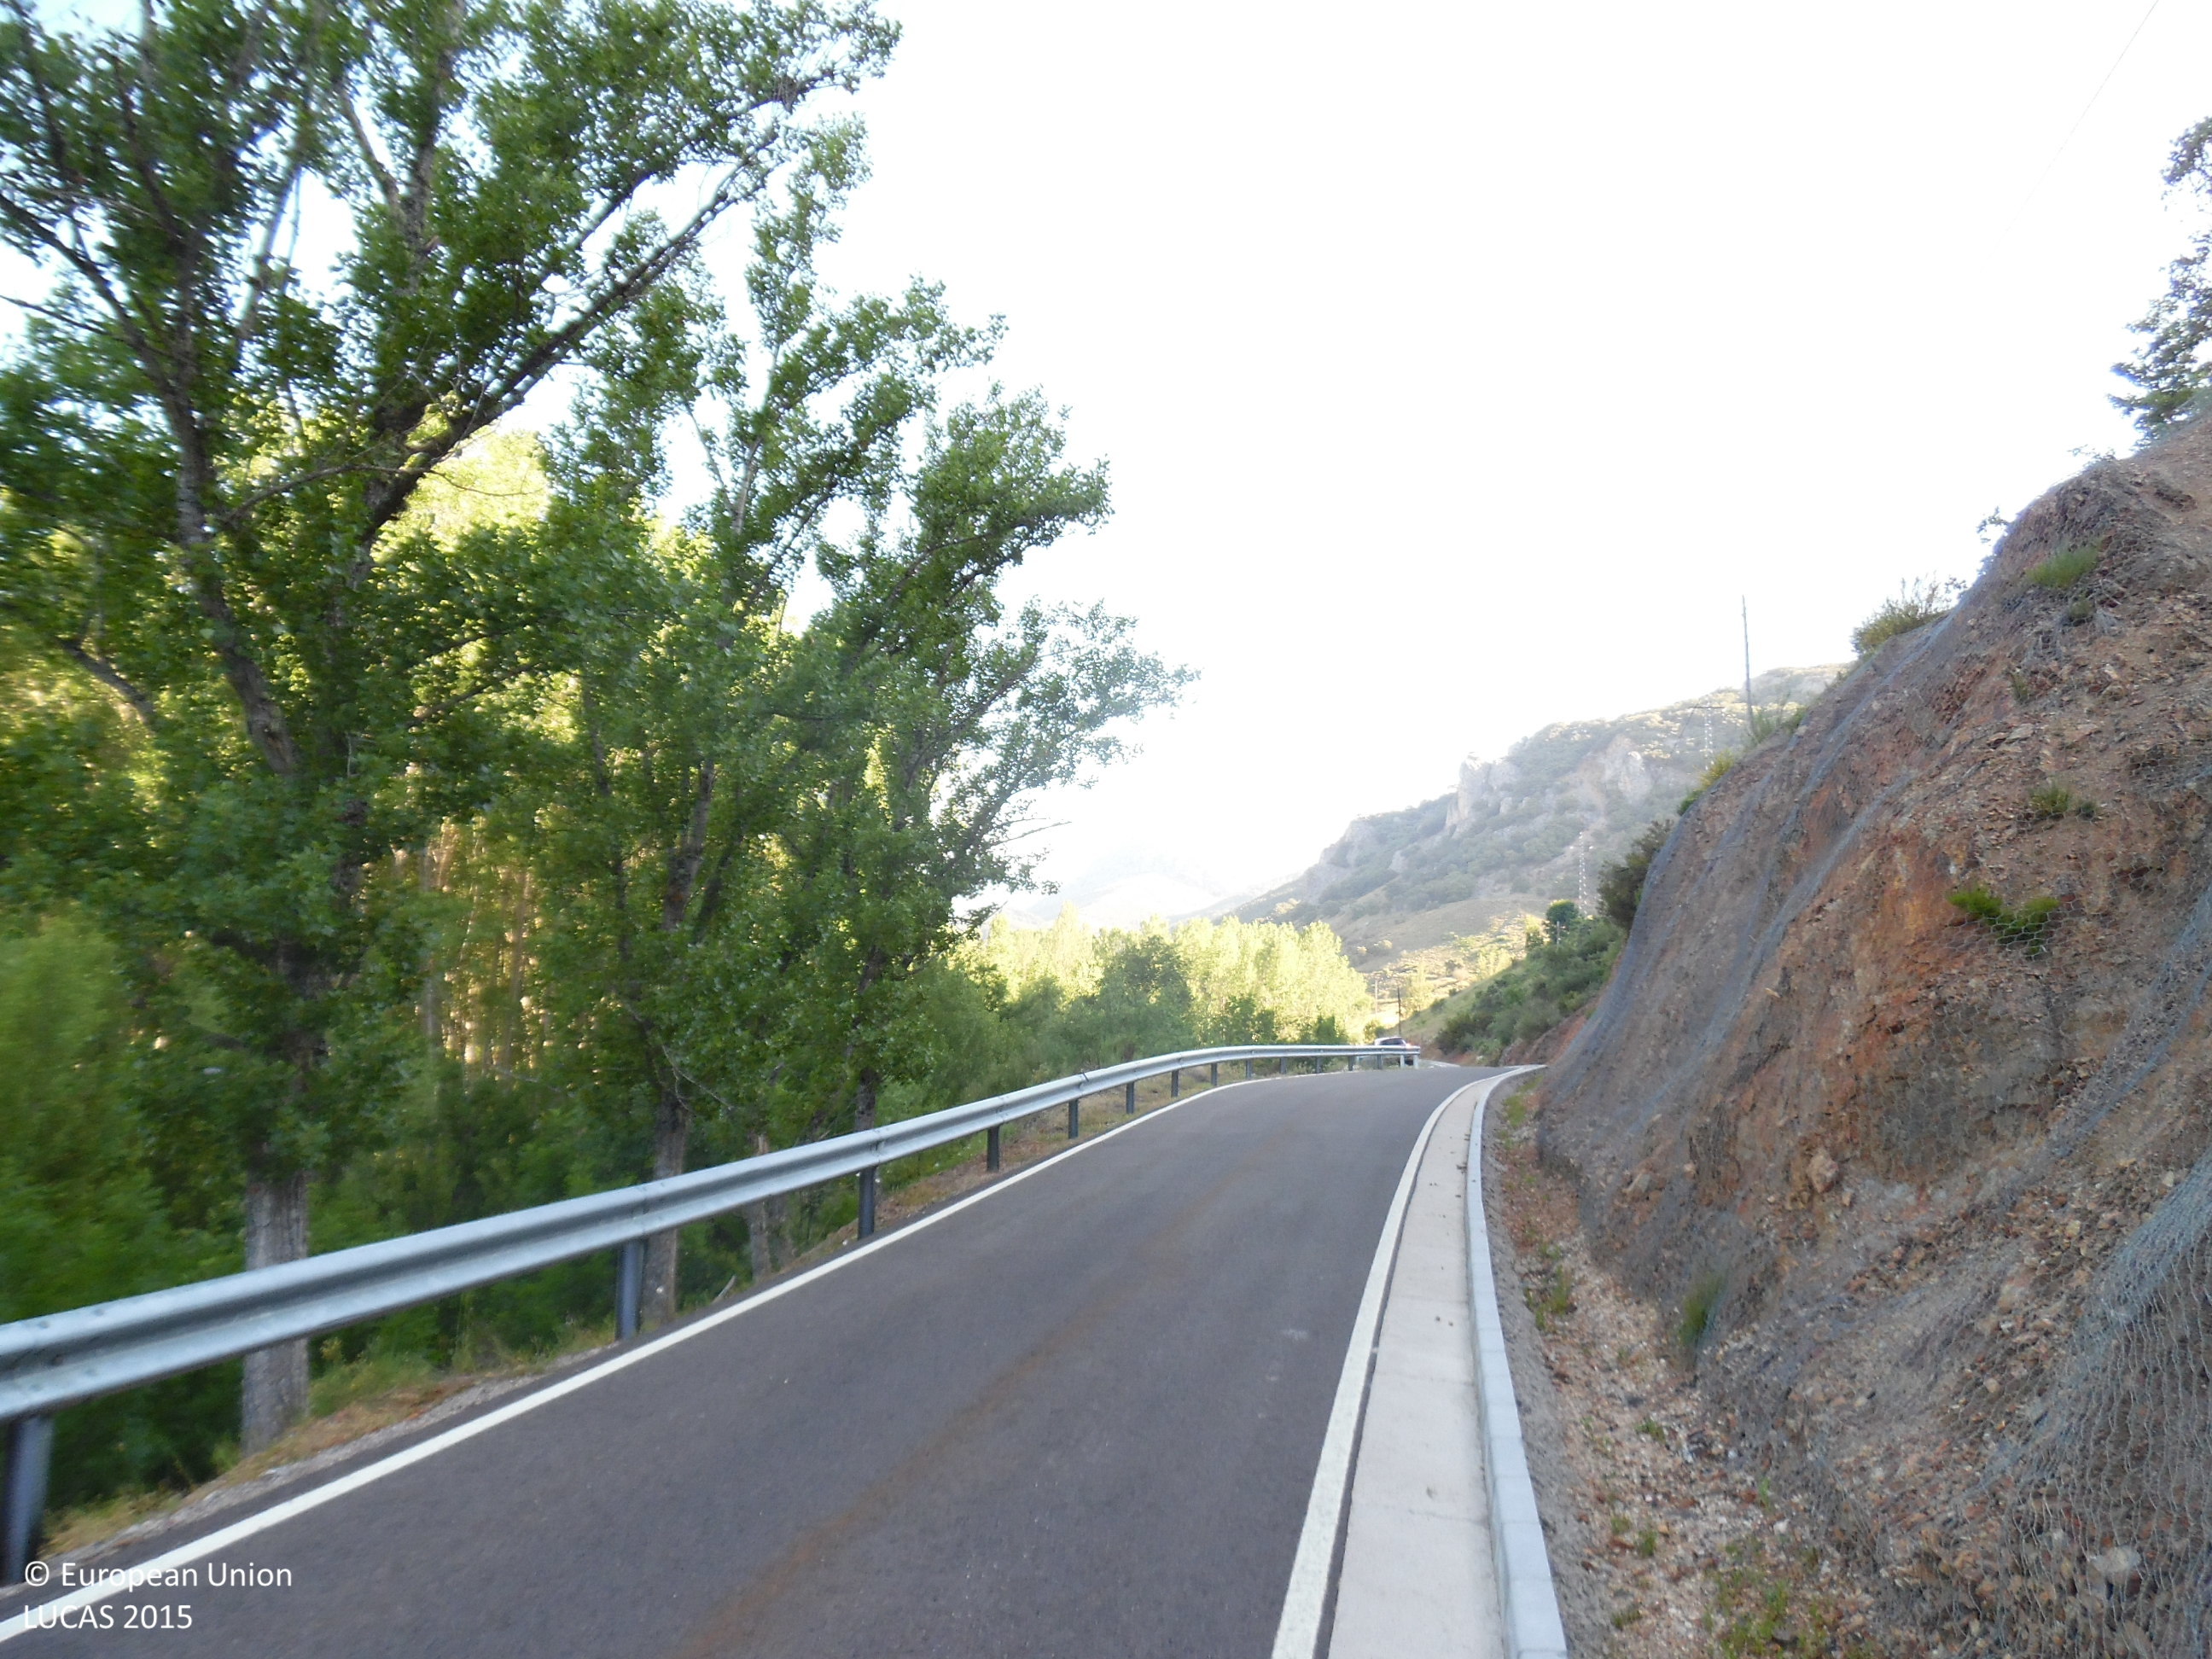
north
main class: Shrubland
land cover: Shrubland with sparse tree cover
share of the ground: > 75 %
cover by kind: shrubs 85 %, unconsolidated bare surface 10 %, broadleaved forest trees 5 %
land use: Abandoned areas
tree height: < 5 m
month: June
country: ES
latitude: 42.8054
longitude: -5.7683
